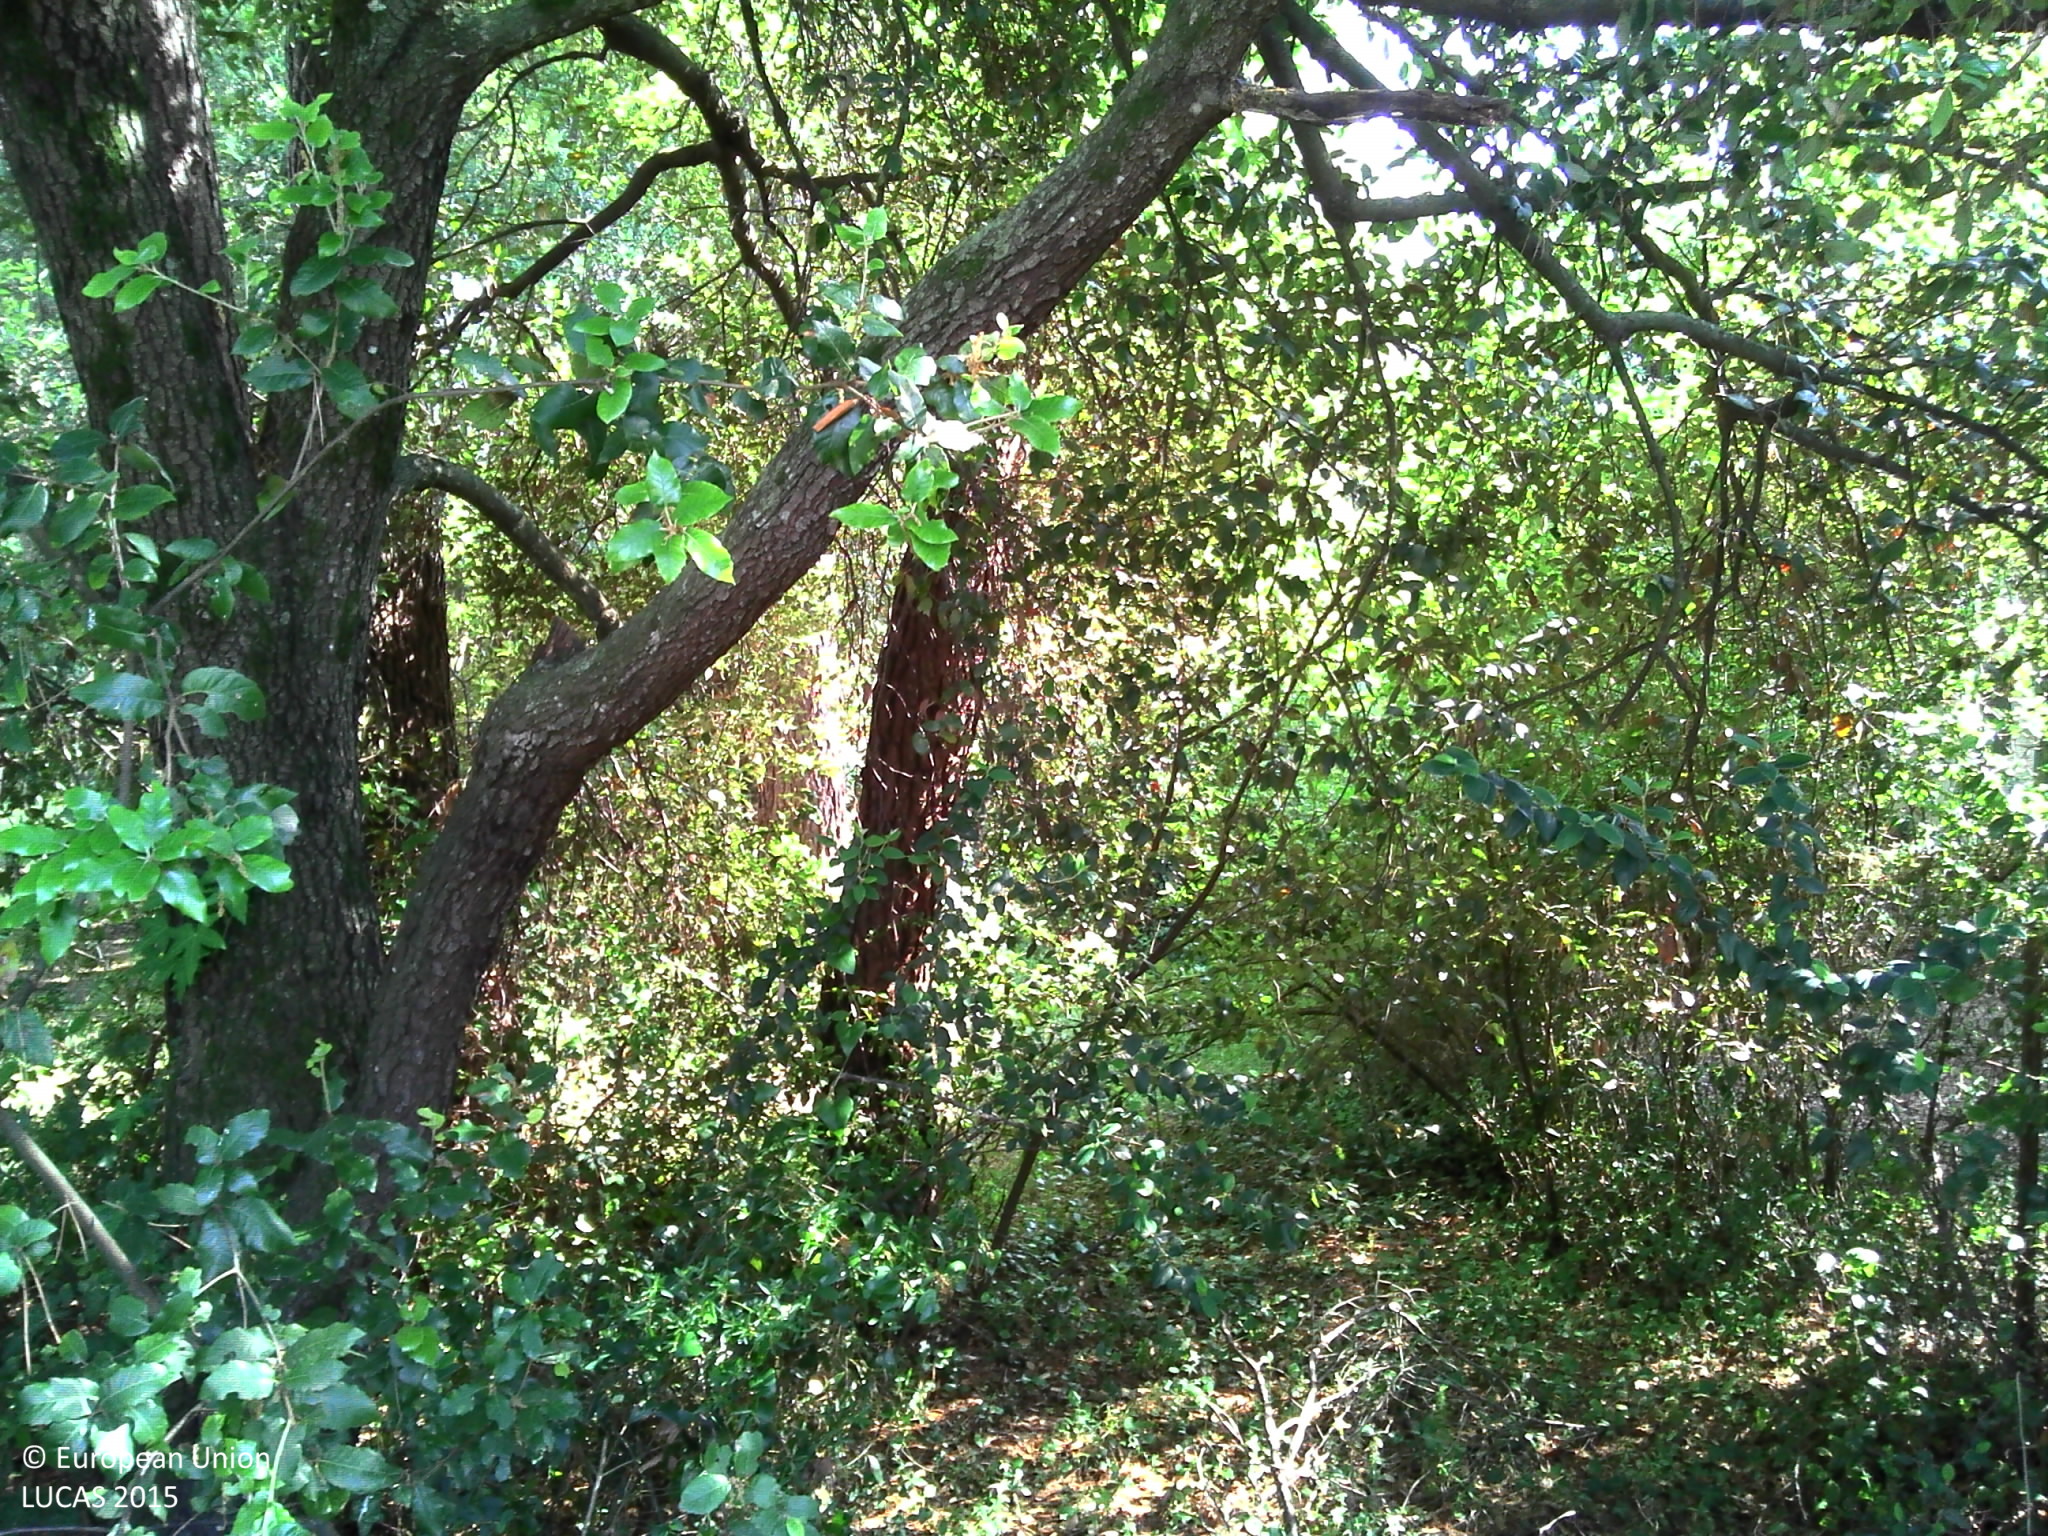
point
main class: Woodland
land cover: Pine dominated mixed woodland
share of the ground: > 75 %
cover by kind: coniferous forest trees 40 %, broadleaved forest trees 40 %, herbaceous plants 20 %
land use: Residential
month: June
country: FR
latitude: 43.6586
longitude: 7.0436
